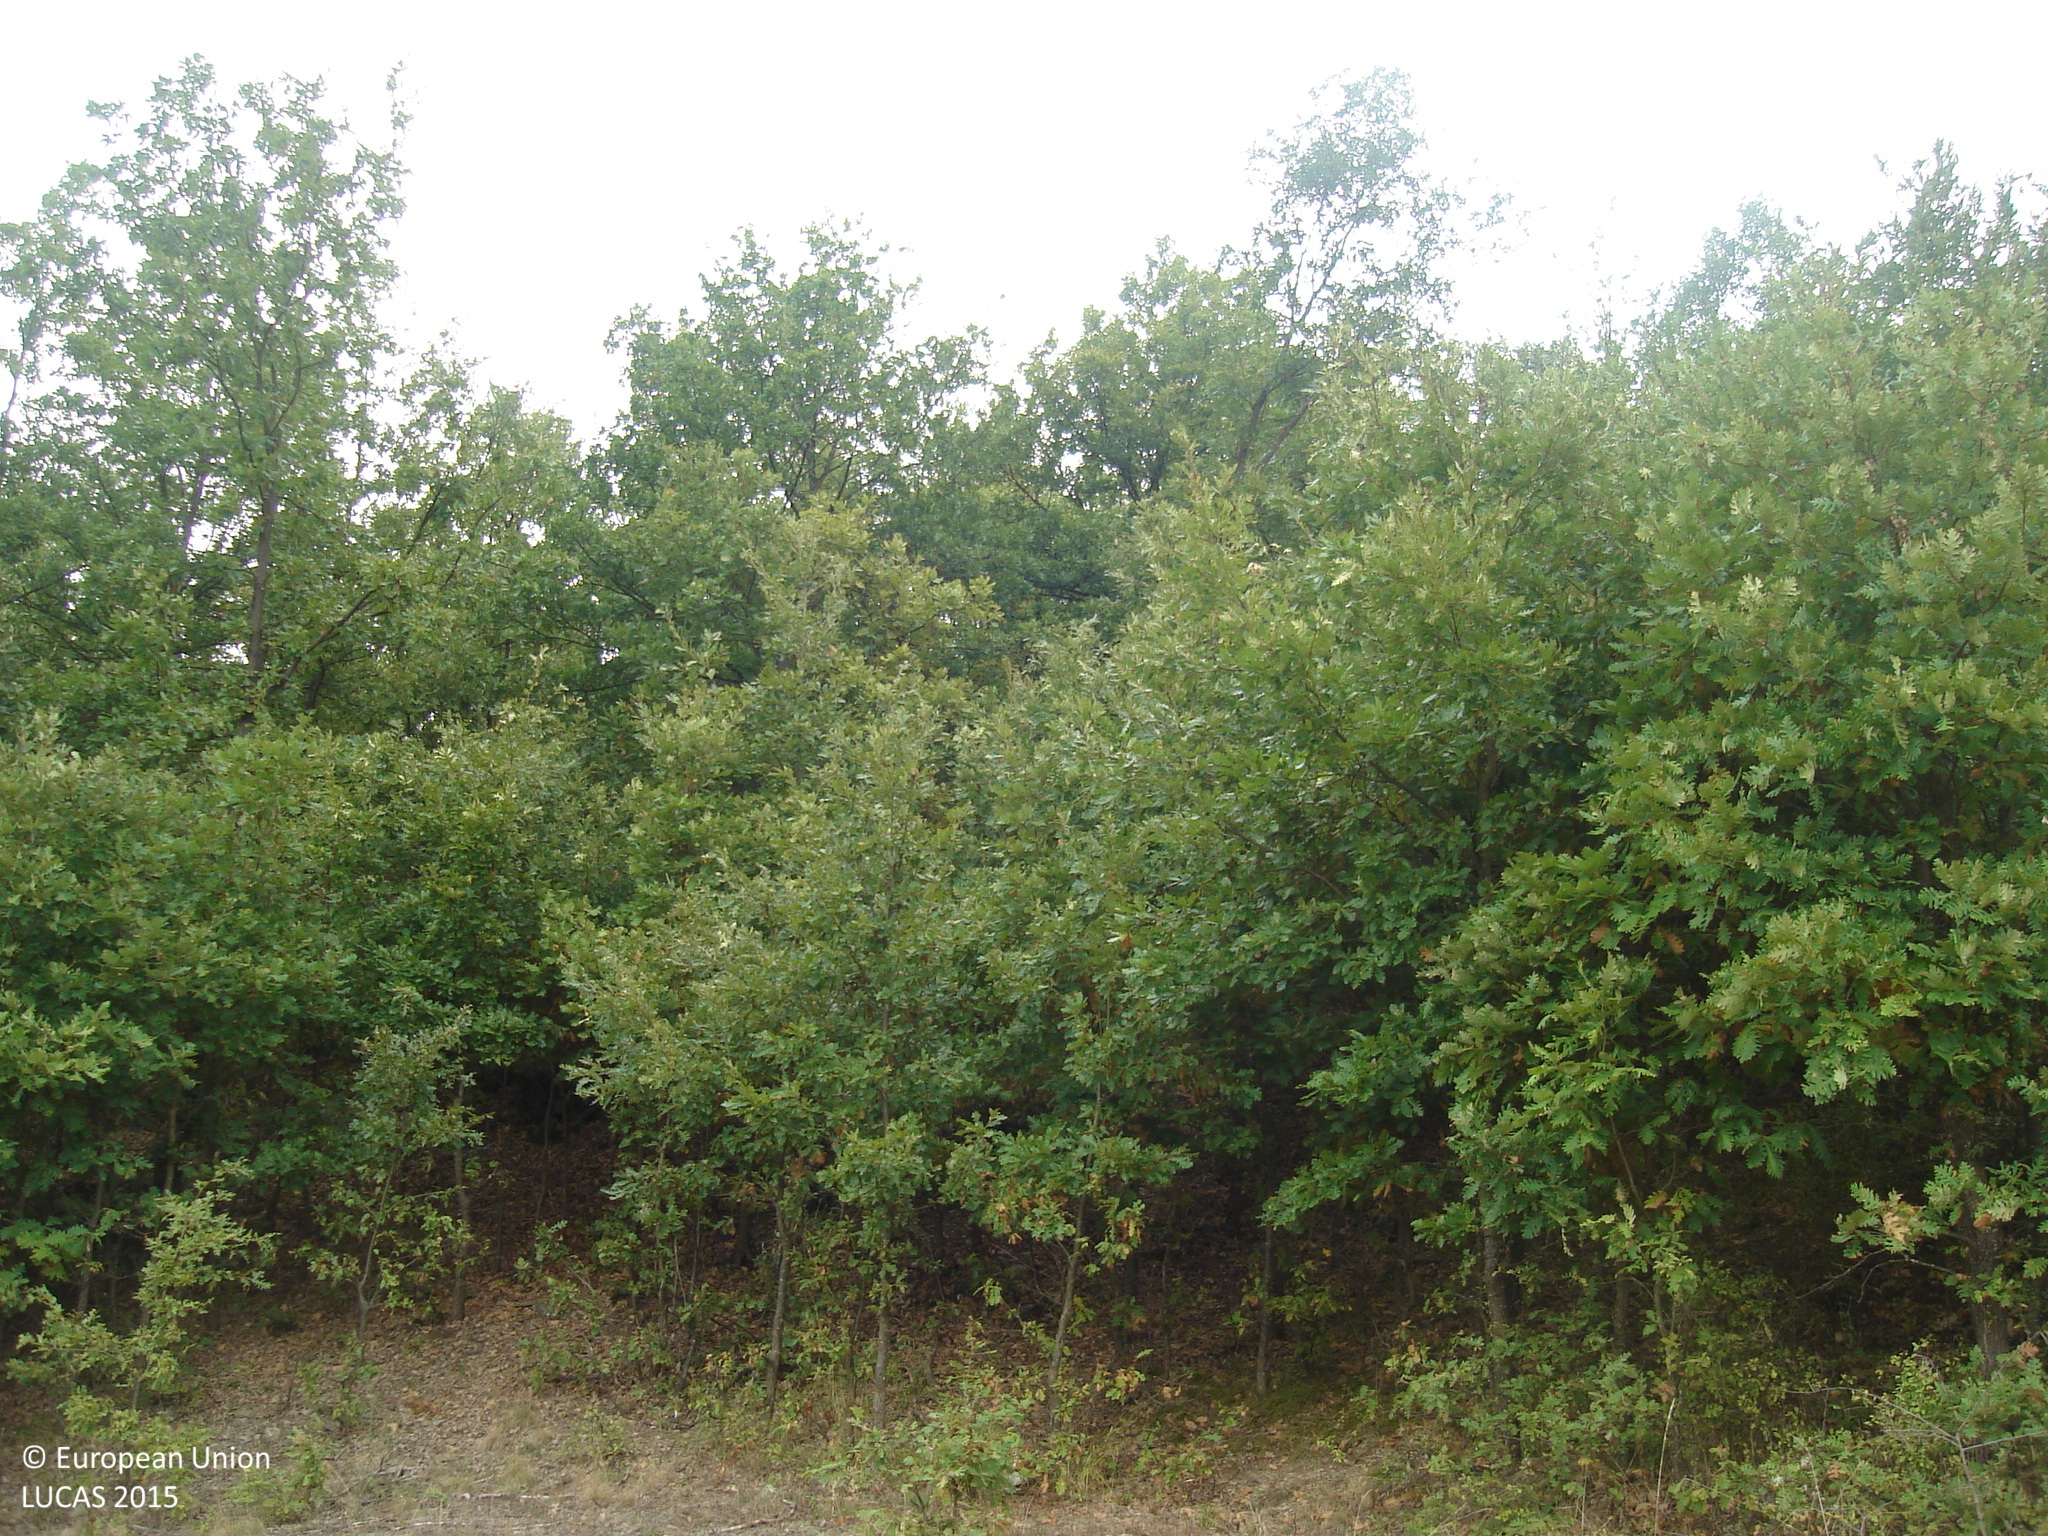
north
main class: Grassland
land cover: Grassland with sparse tree/shrub cover
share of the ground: > 75 %
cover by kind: herbaceous plants 85 %, shrubs 10 %, broadleaved forest trees 5 %
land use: Semi-natural and natural areas not in use
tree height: < 5 m
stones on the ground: < 10 %
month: September
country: BG
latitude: 42.9796
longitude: 23.2926
